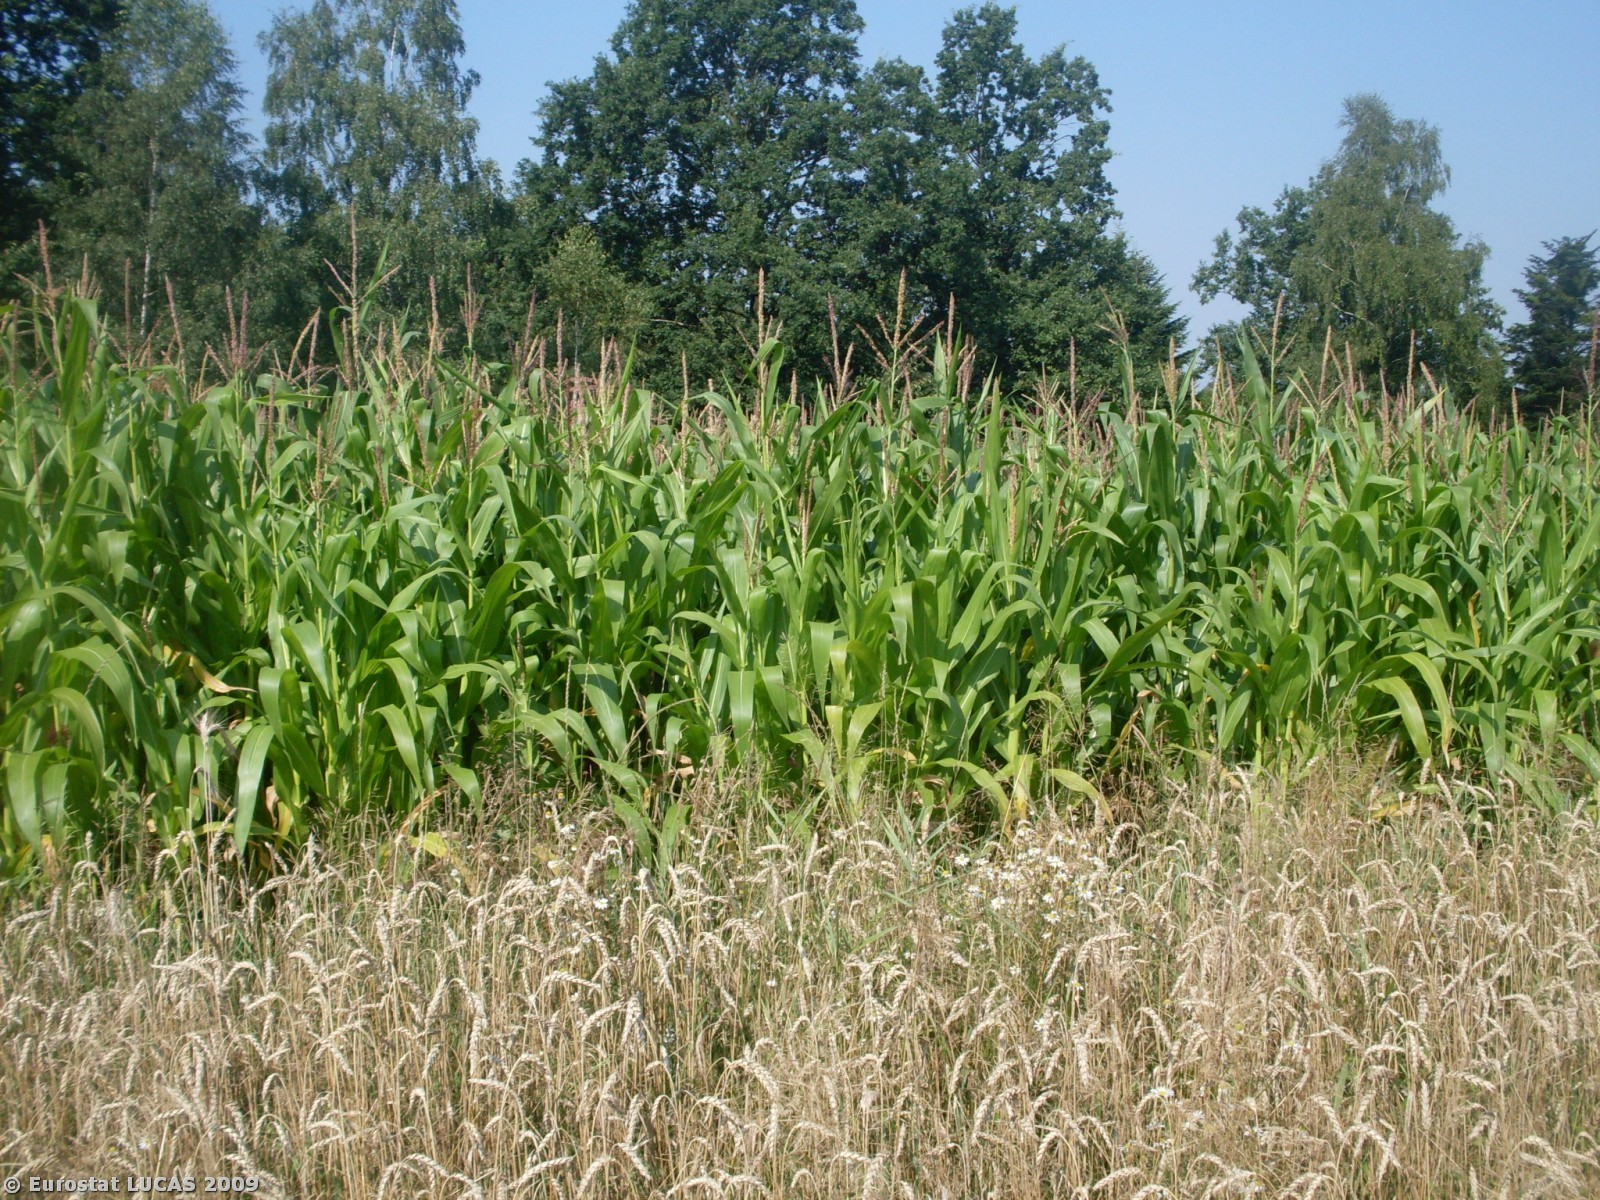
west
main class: Cropland
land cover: Common wheat
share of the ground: > 75 %
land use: Agriculture (excluding fallow land and kitchen gardens)
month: August
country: PL
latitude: 49.9490
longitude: 20.5319
